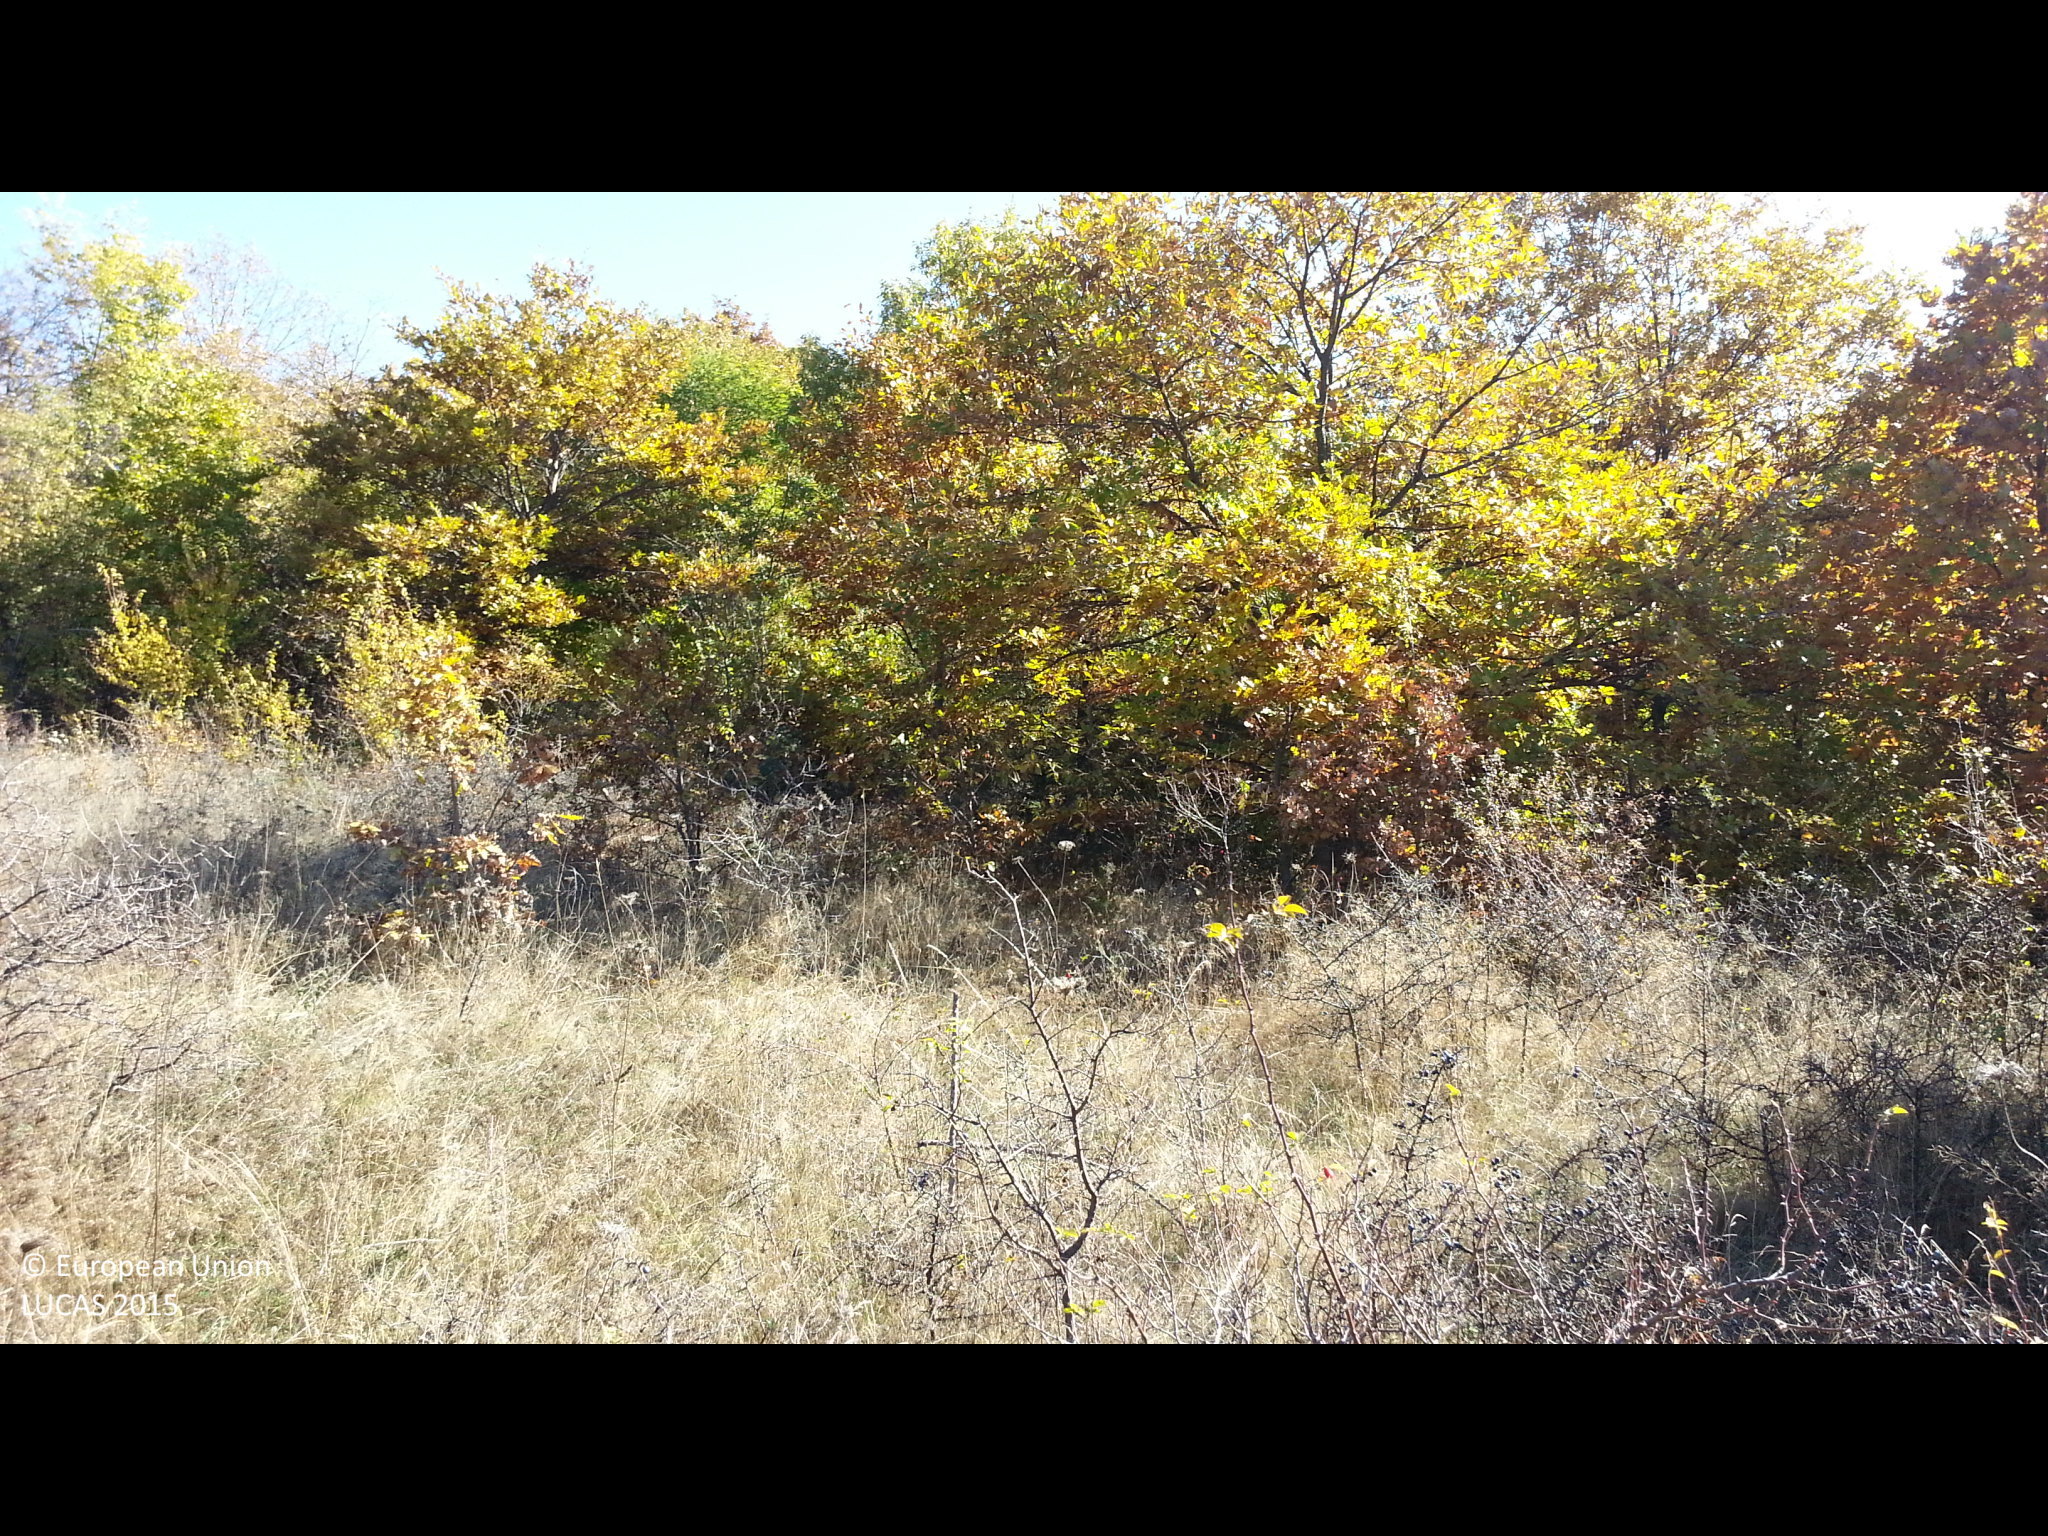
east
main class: Shrubland
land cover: Shrubland with sparse tree cover
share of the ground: 25 - 50 %
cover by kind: herbaceous plants 55 %, shrubs 40 %, broadleaved forest trees 5 %
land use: Semi-natural and natural areas not in use
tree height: < 5 m
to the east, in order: Shrubland with sparse tree cover; Broadleaved woodland; Rivers and streams; Broadleaved woodland; Grass margins; Common wheat; Grass margins; Broadleaved woodland
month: November
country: BG
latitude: 42.7079
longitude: 23.9501
